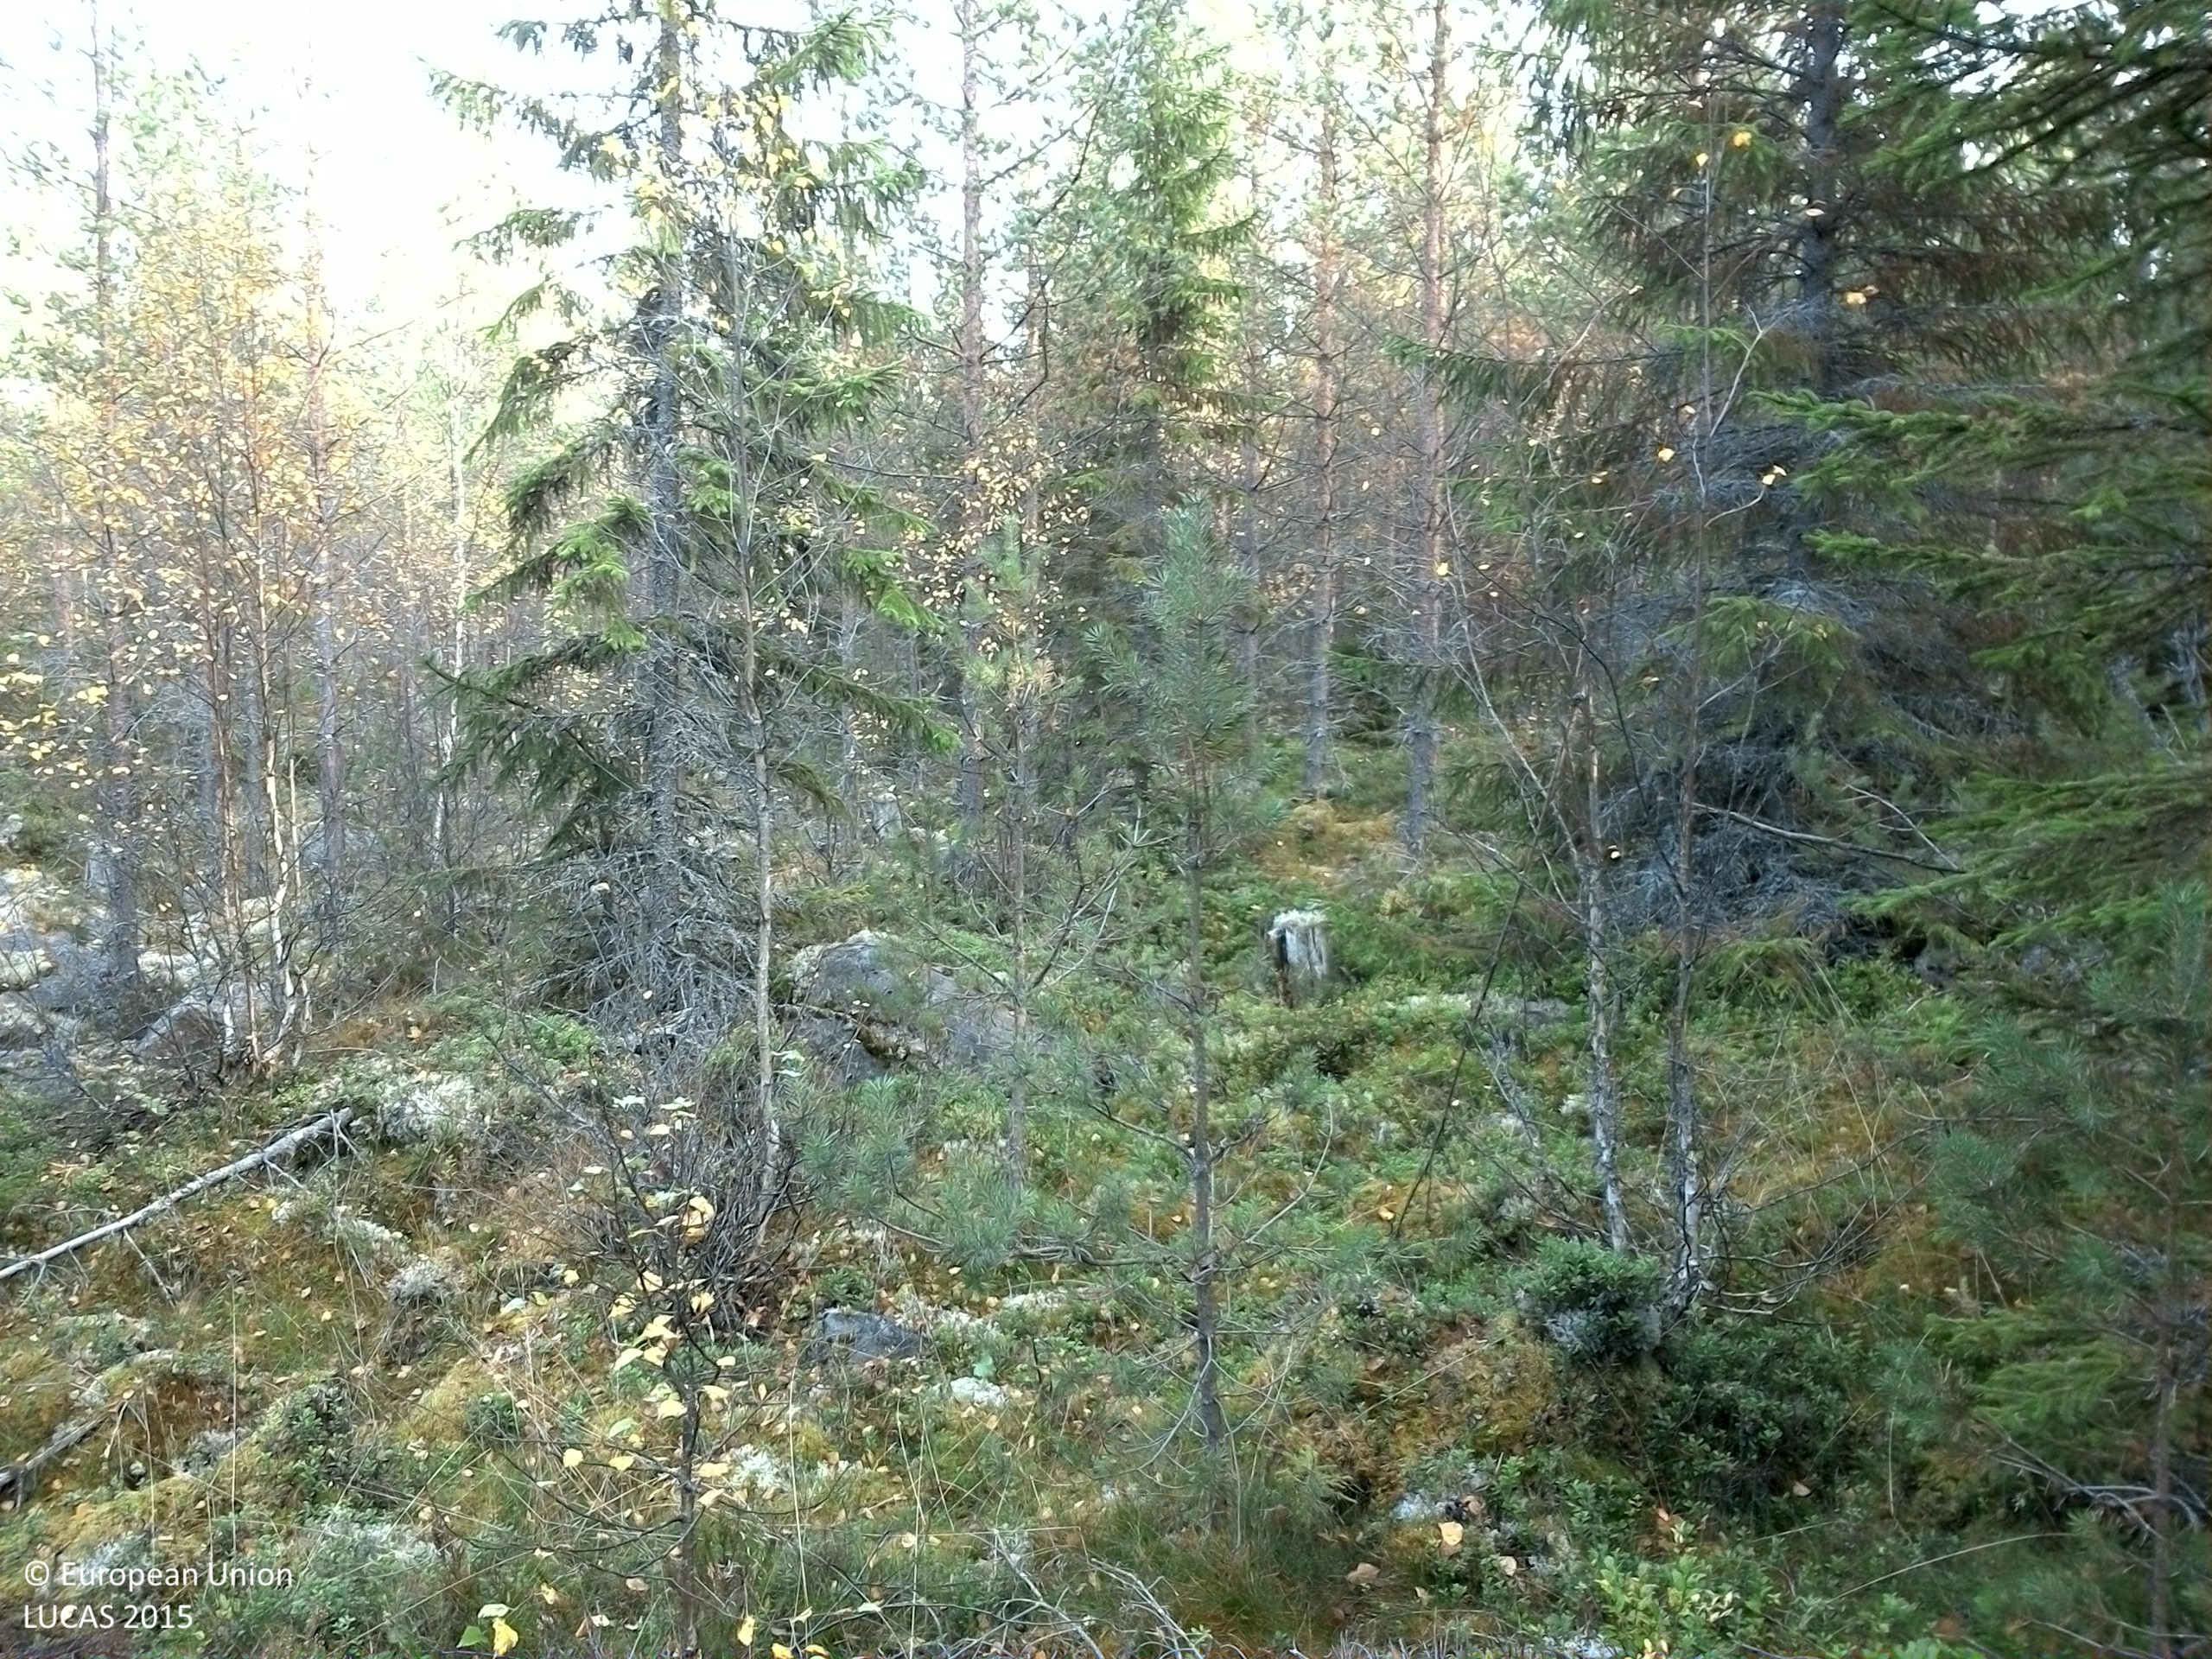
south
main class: Woodland
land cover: Other coniferous woodland
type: boreal forest
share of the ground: 50 - 75 %
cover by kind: coniferous forest trees 55 %, shrubs 25 %, lichens and mosses 10 %, broadleaved forest trees 5 %, consolidated bare surface 5 %
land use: Forestry
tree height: > 5 m
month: October
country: SE
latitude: 61.2805
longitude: 15.0780
